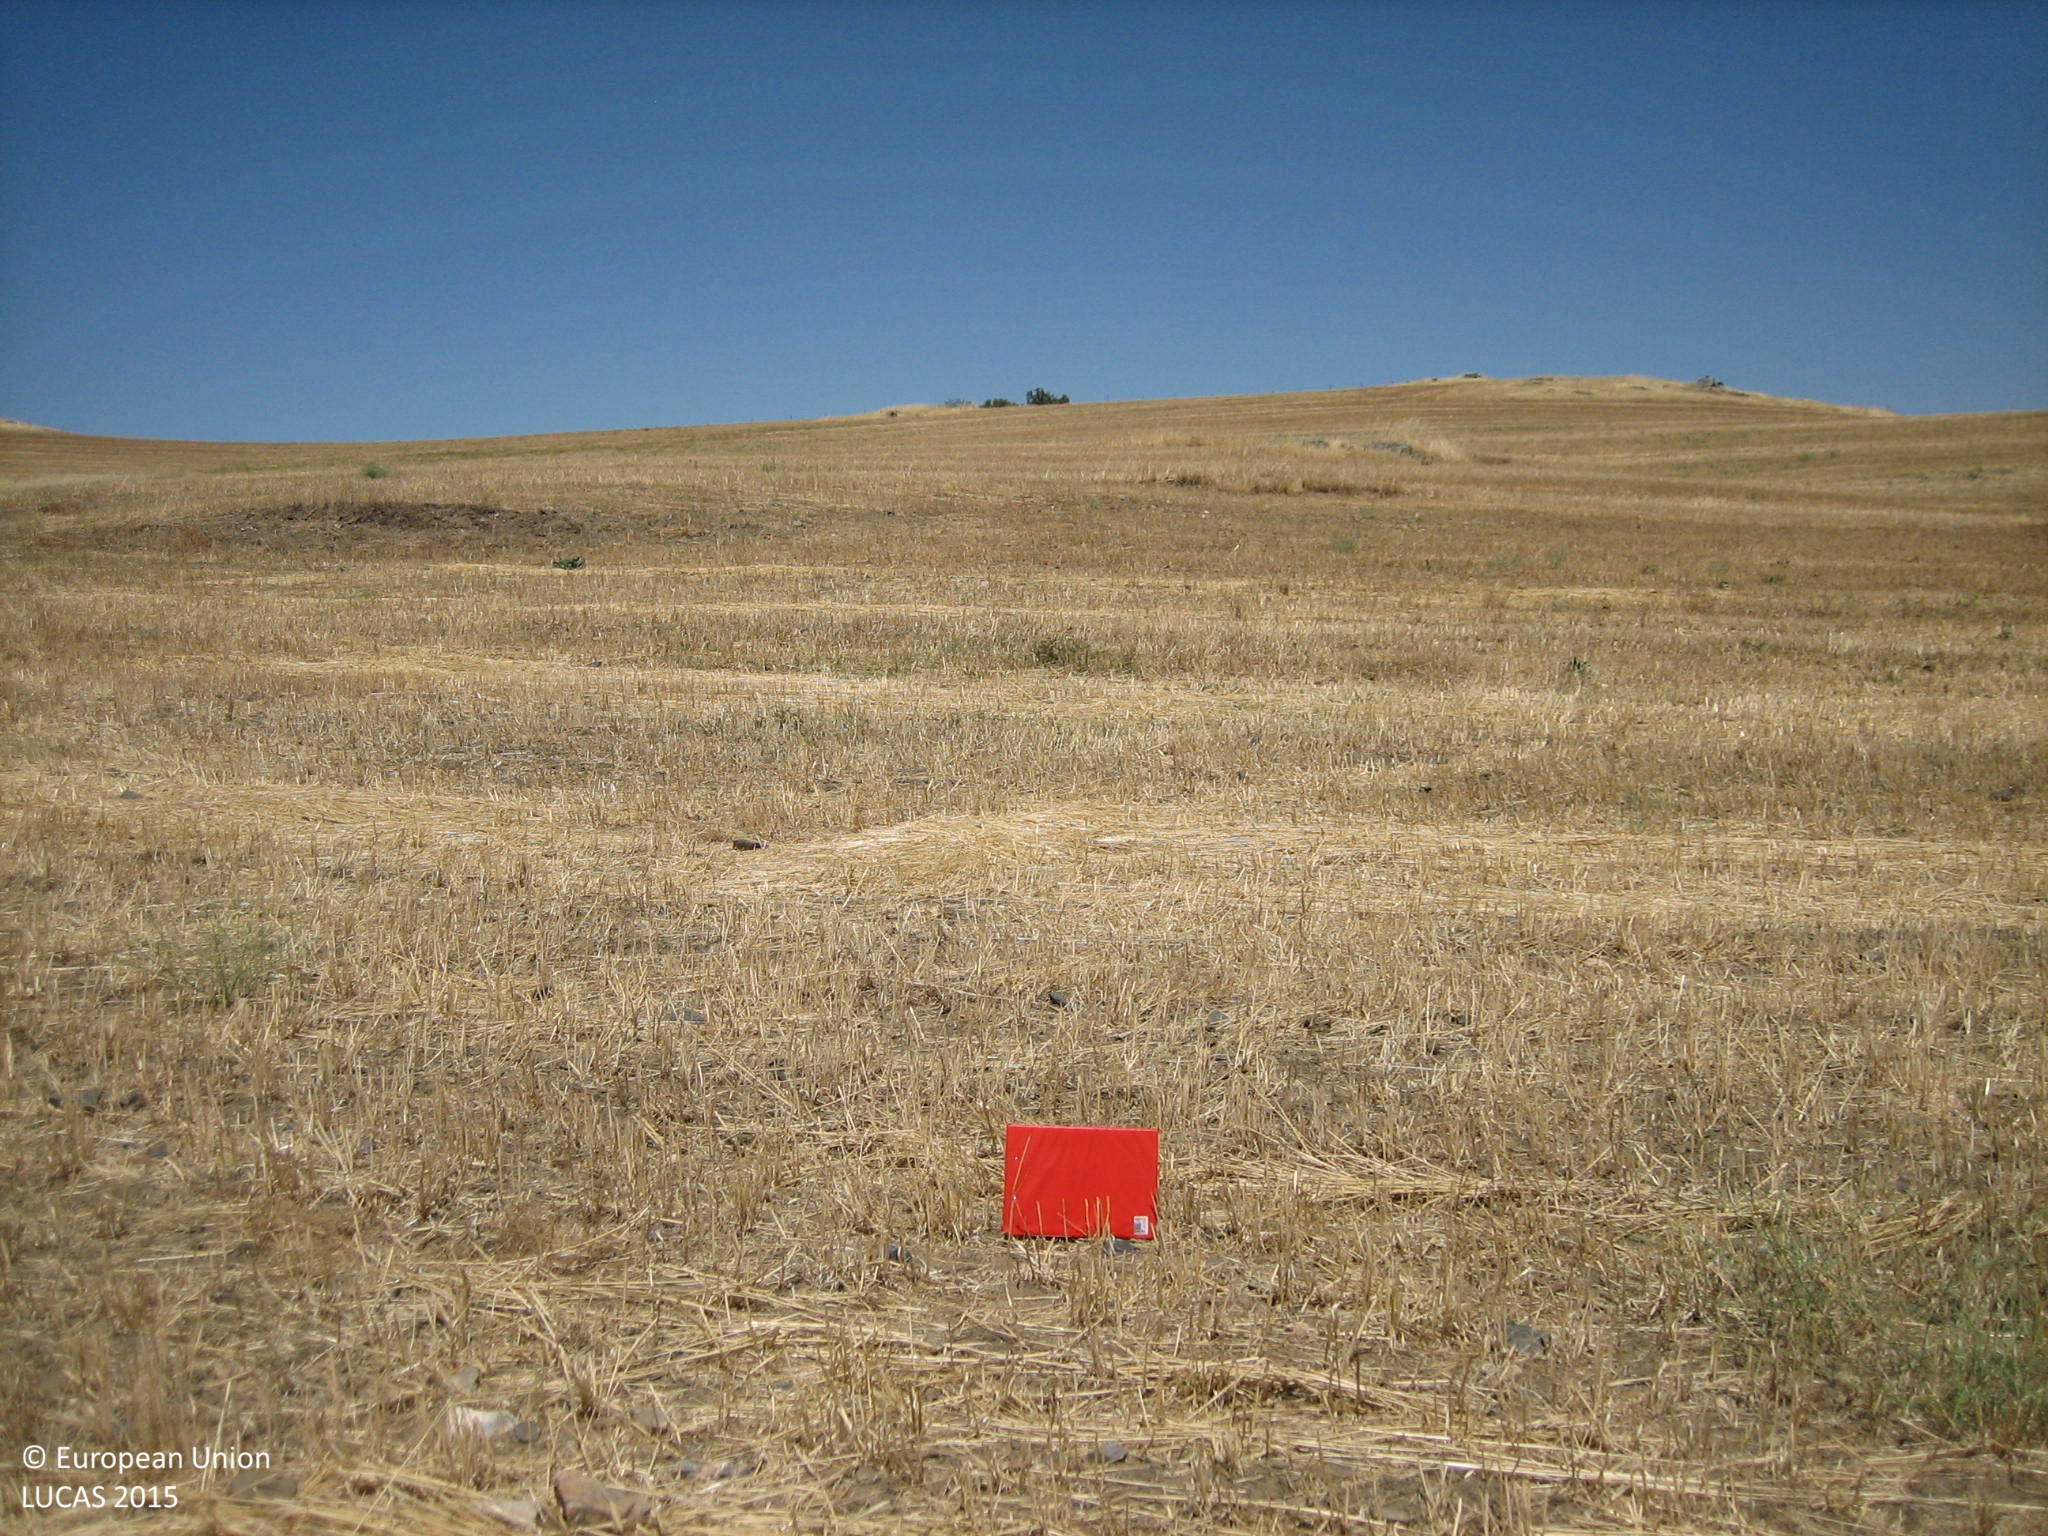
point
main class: Cropland
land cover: Common wheat
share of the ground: < 10 %
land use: Agriculture (excluding fallow land and kitchen gardens)
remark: Harvested field
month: July
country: ES
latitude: 38.1635
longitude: -6.2612
